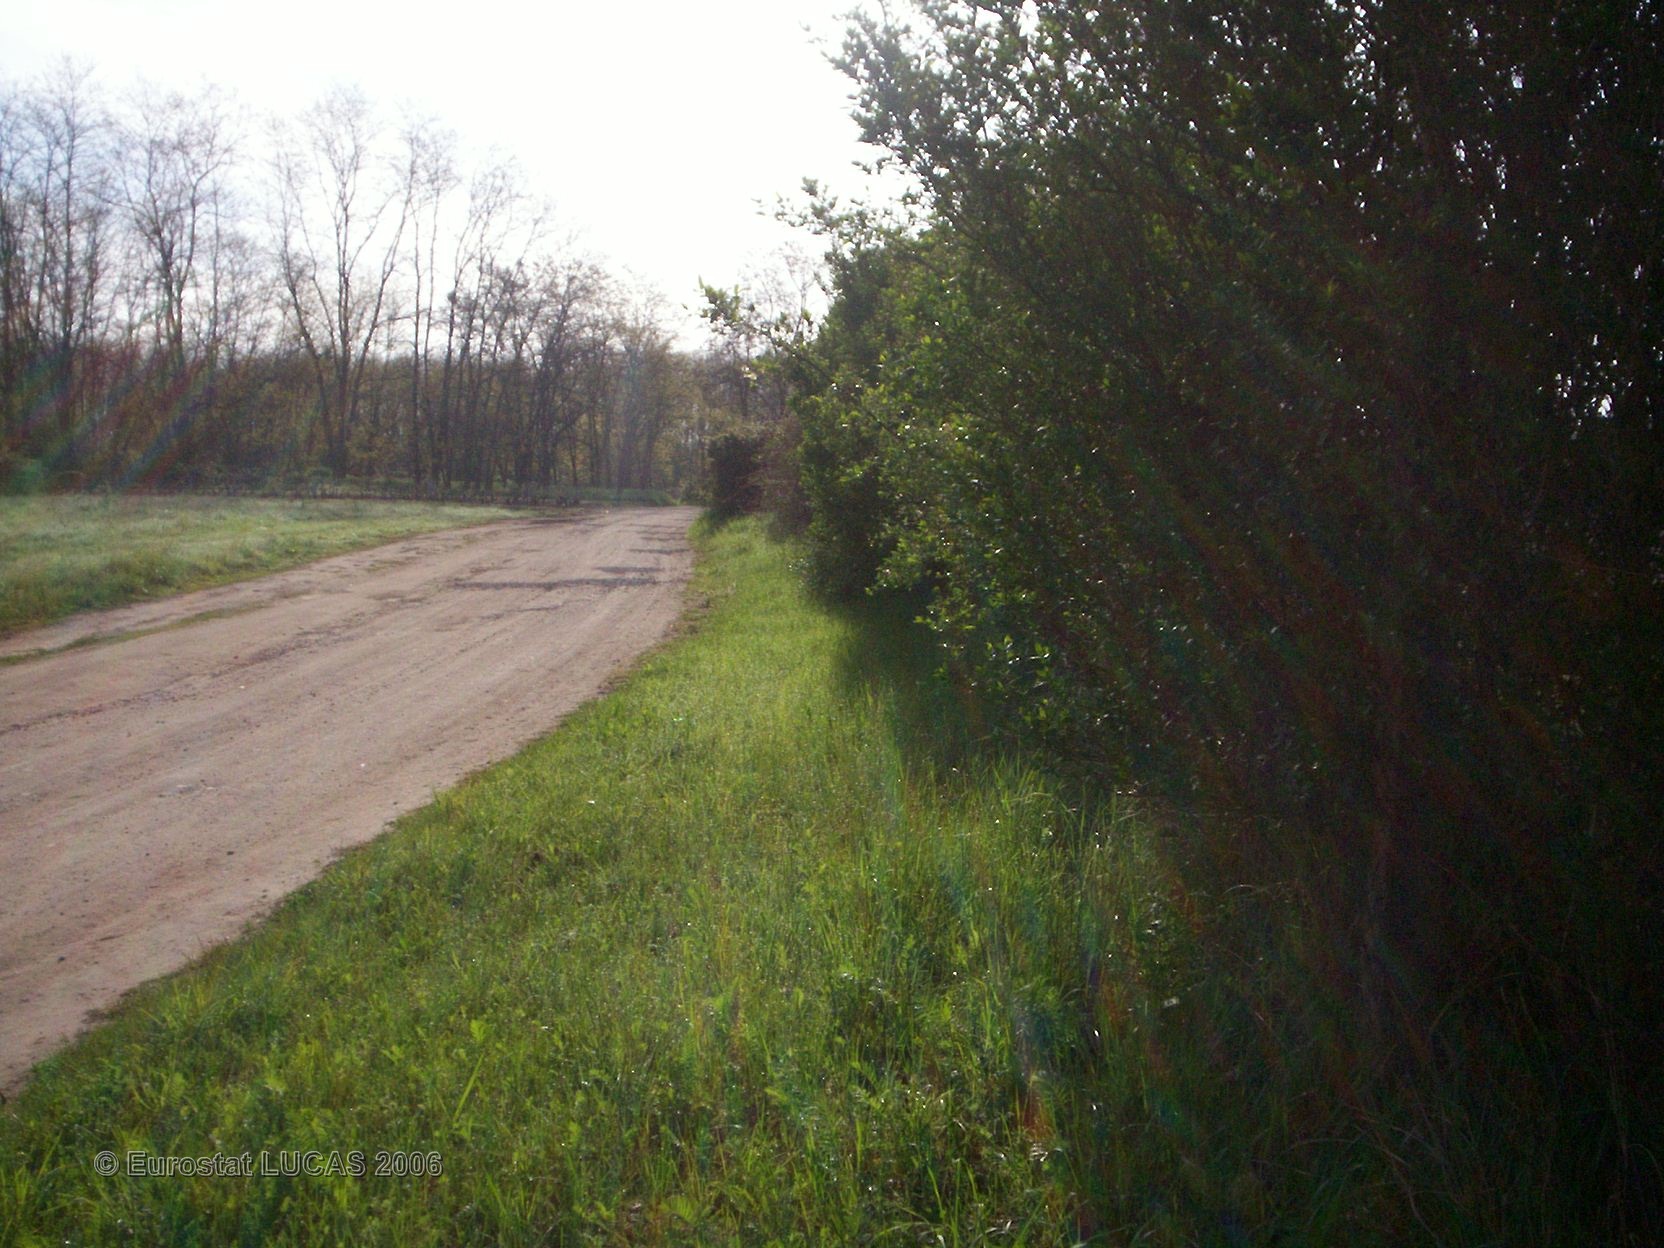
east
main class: Grassland
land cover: Grassland with sparse tree/shrub cover
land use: Logistics and storage
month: May
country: FR
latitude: 47.2768
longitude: 2.9753
